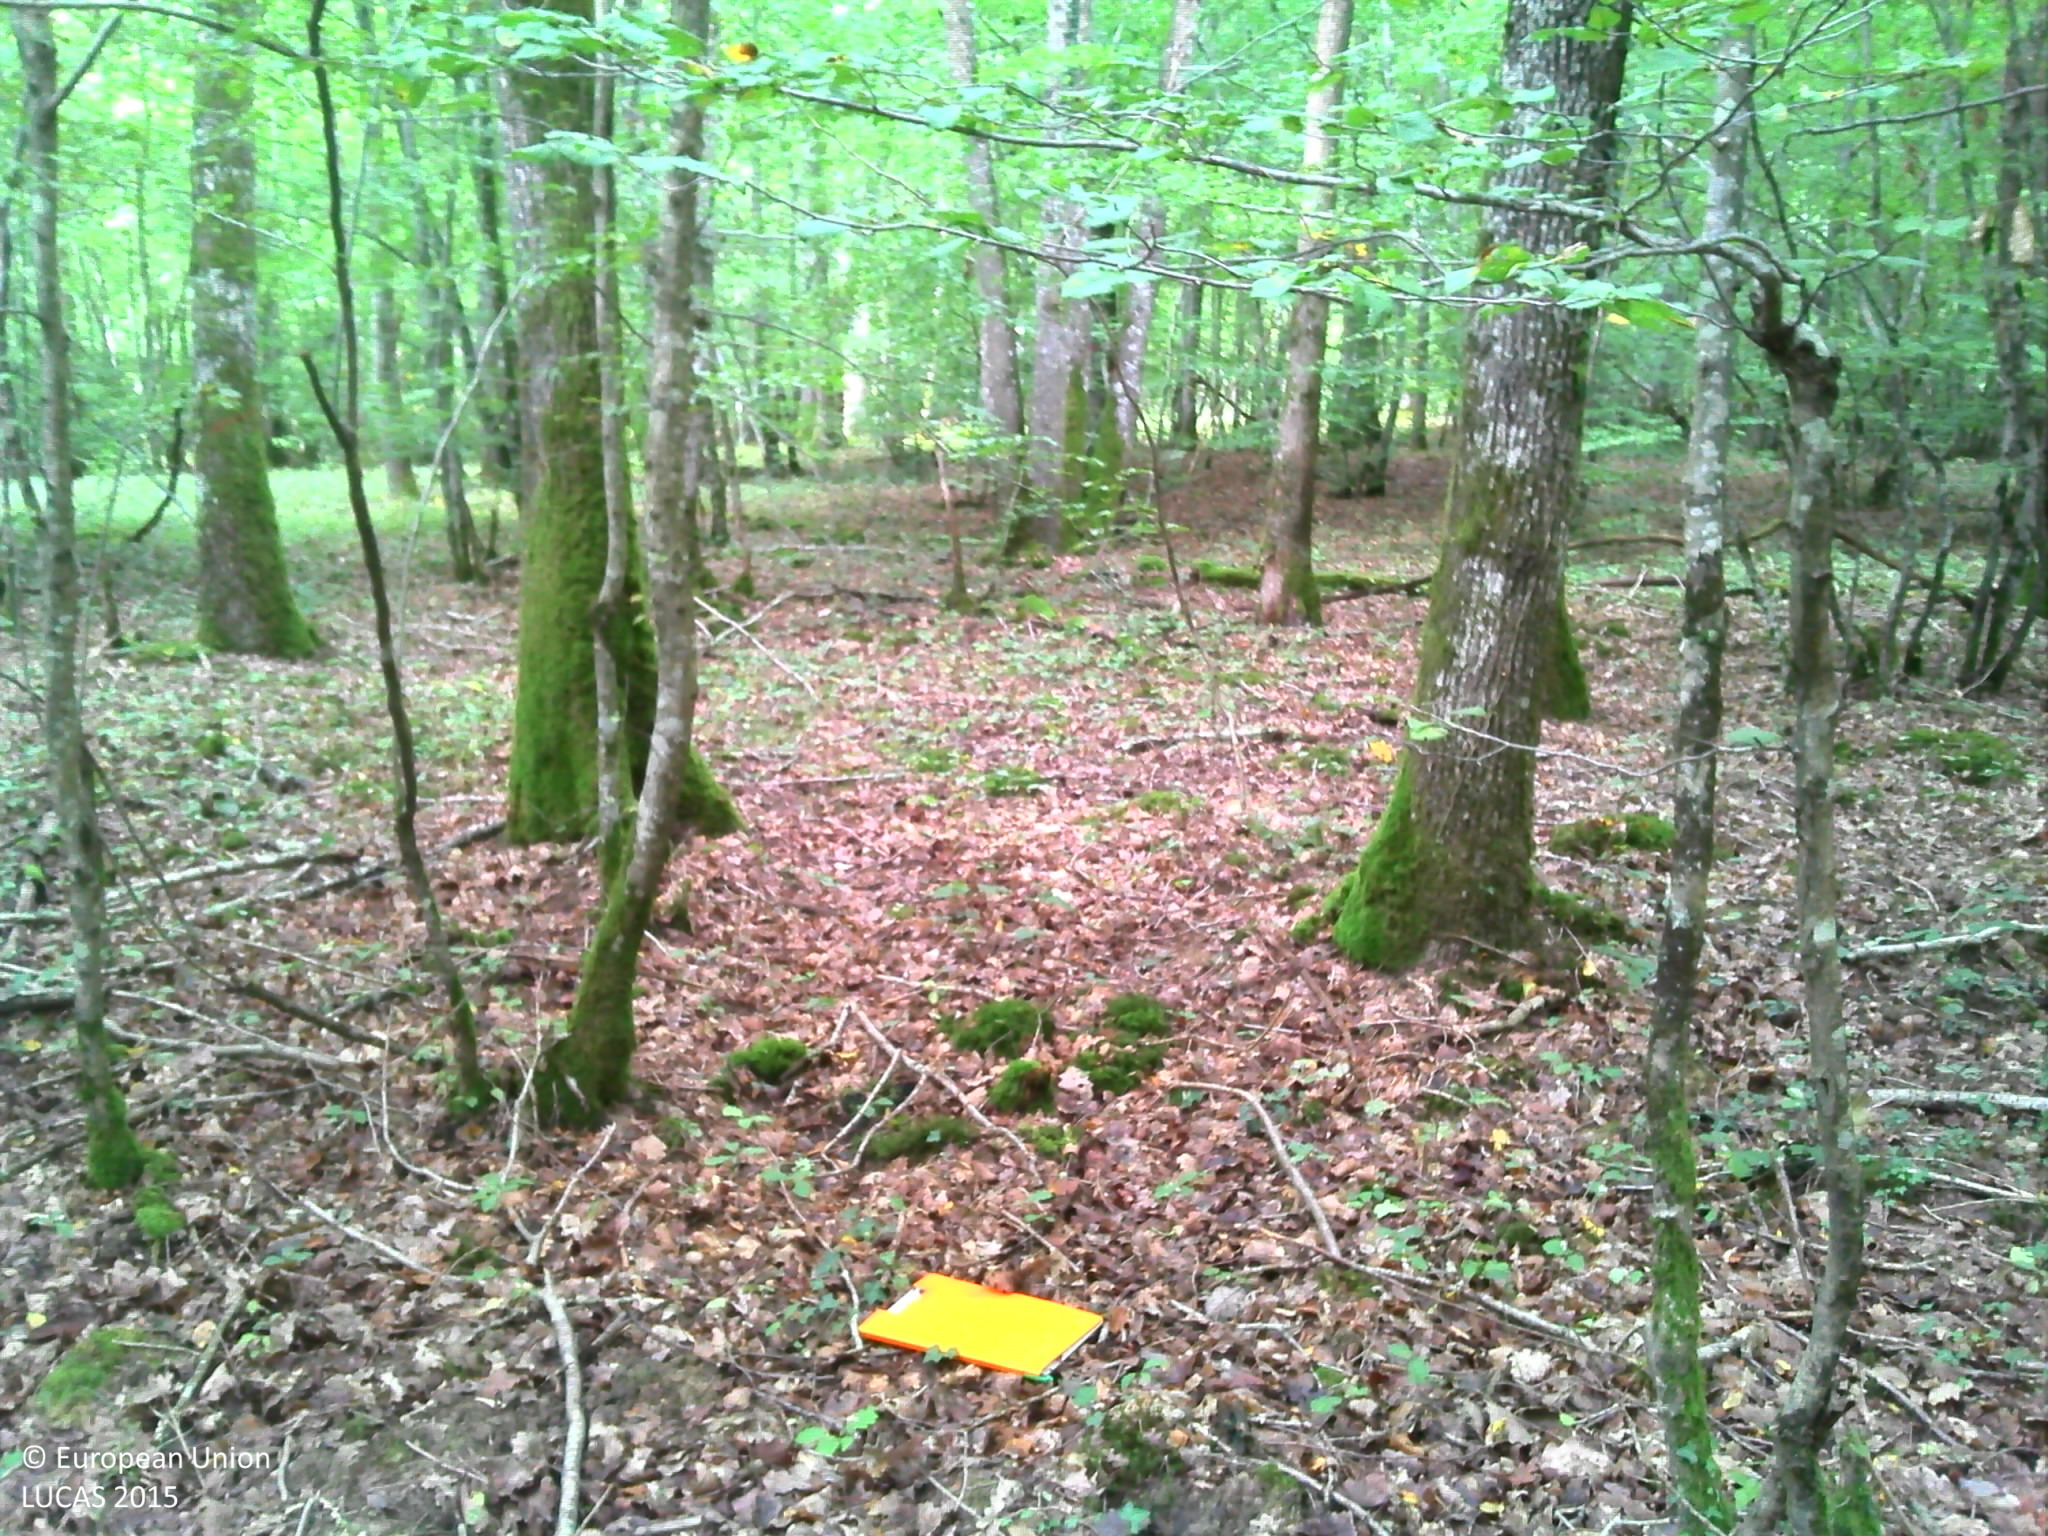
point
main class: Woodland
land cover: Broadleaved woodland
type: mesophytic deciduous forest
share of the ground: > 75 %
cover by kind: broadleaved forest trees 90 %, unconsolidated bare surface 10 %
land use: Forestry
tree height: > 5 m
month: July
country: FR
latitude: 46.8287
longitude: 3.6141
